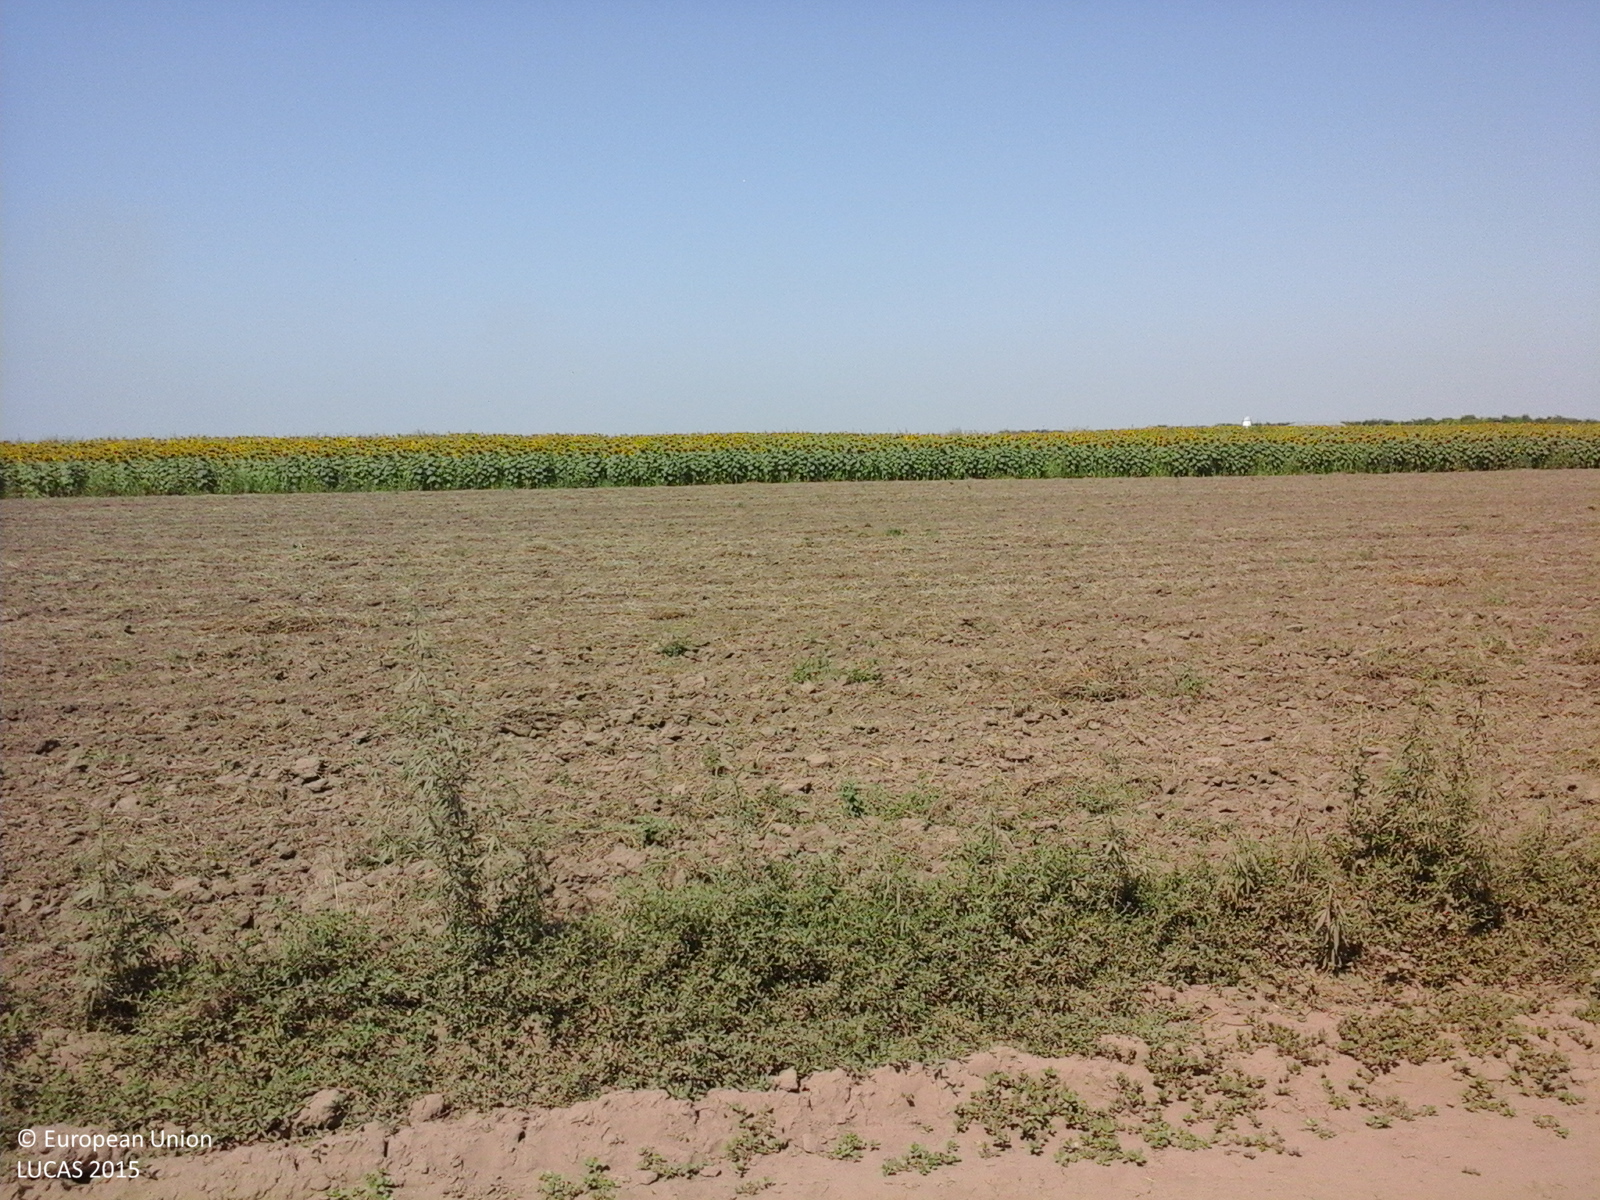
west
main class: Cropland
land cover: Sunflower
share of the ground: > 75 %
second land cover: Other fibre and oleaginous crops
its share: 50 - 75 %
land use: Agriculture (excluding fallow land and kitchen gardens)
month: July
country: RO
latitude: 44.2651
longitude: 27.5153
